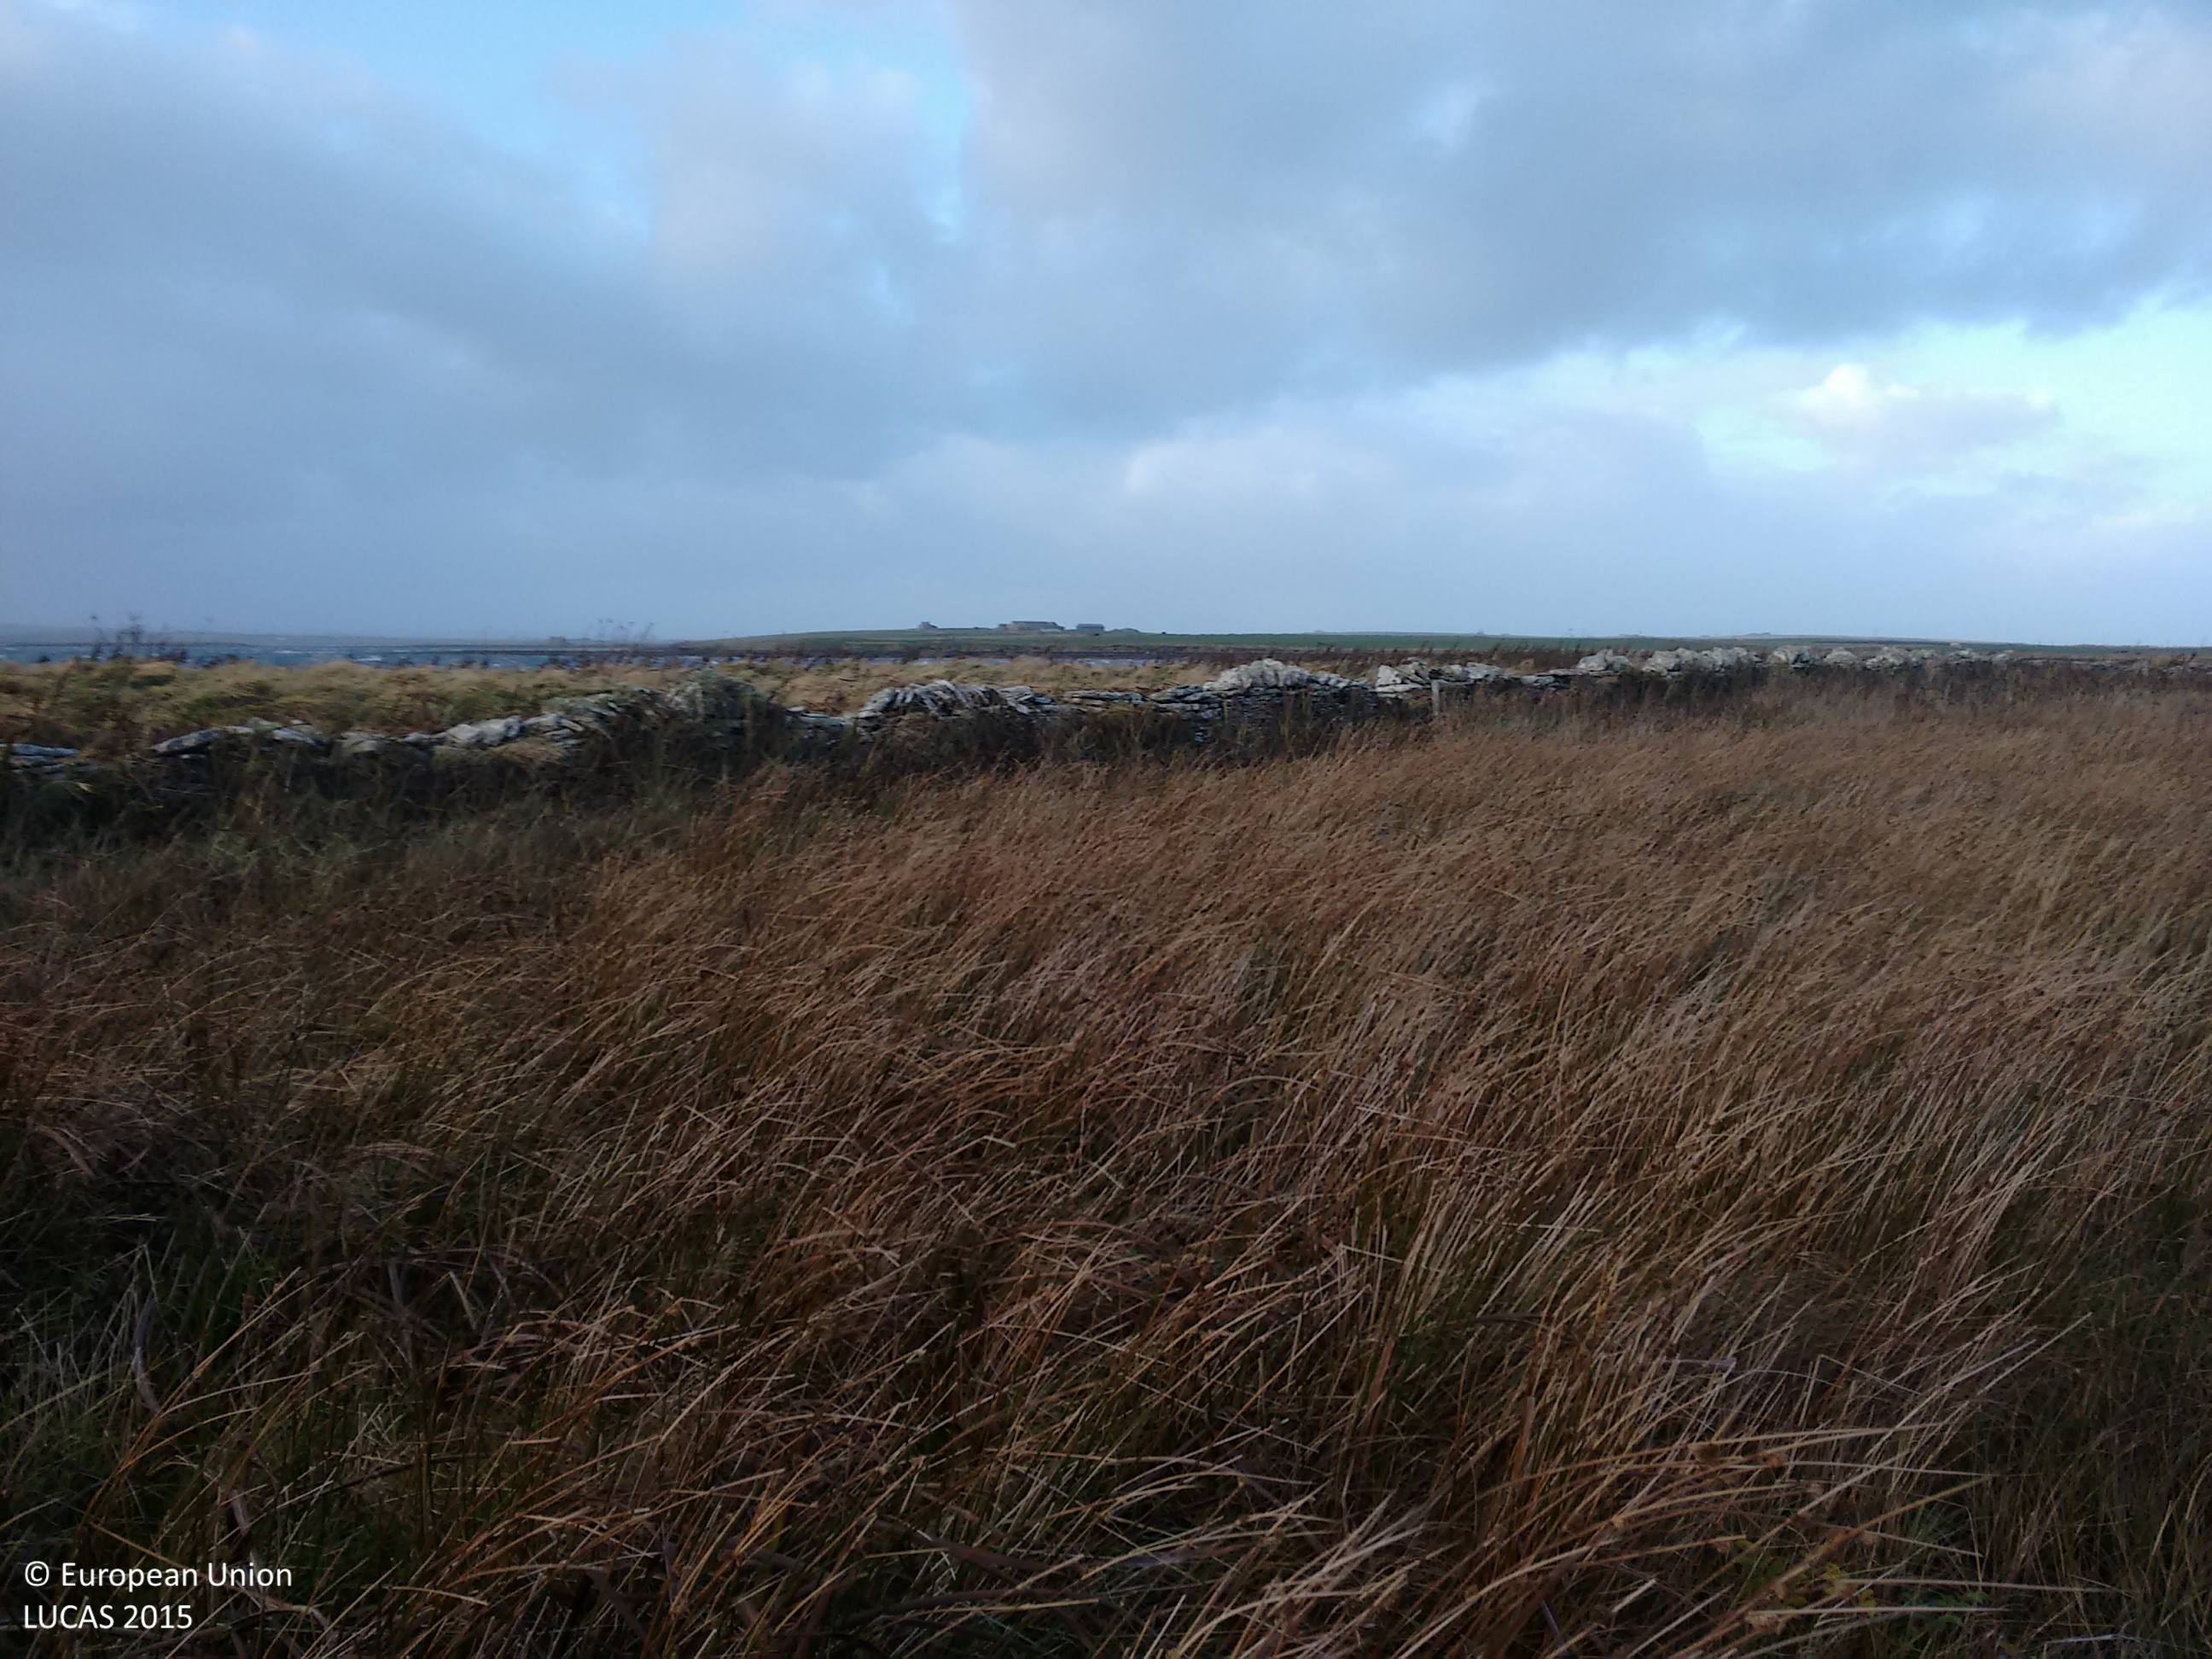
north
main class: Grassland
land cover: Grassland without tree/shrub cover
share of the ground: > 75 %
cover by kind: herbaceous plants 100 %
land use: Agriculture (excluding fallow land and kitchen gardens)
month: November
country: GB
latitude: 58.9381
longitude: -2.7860
